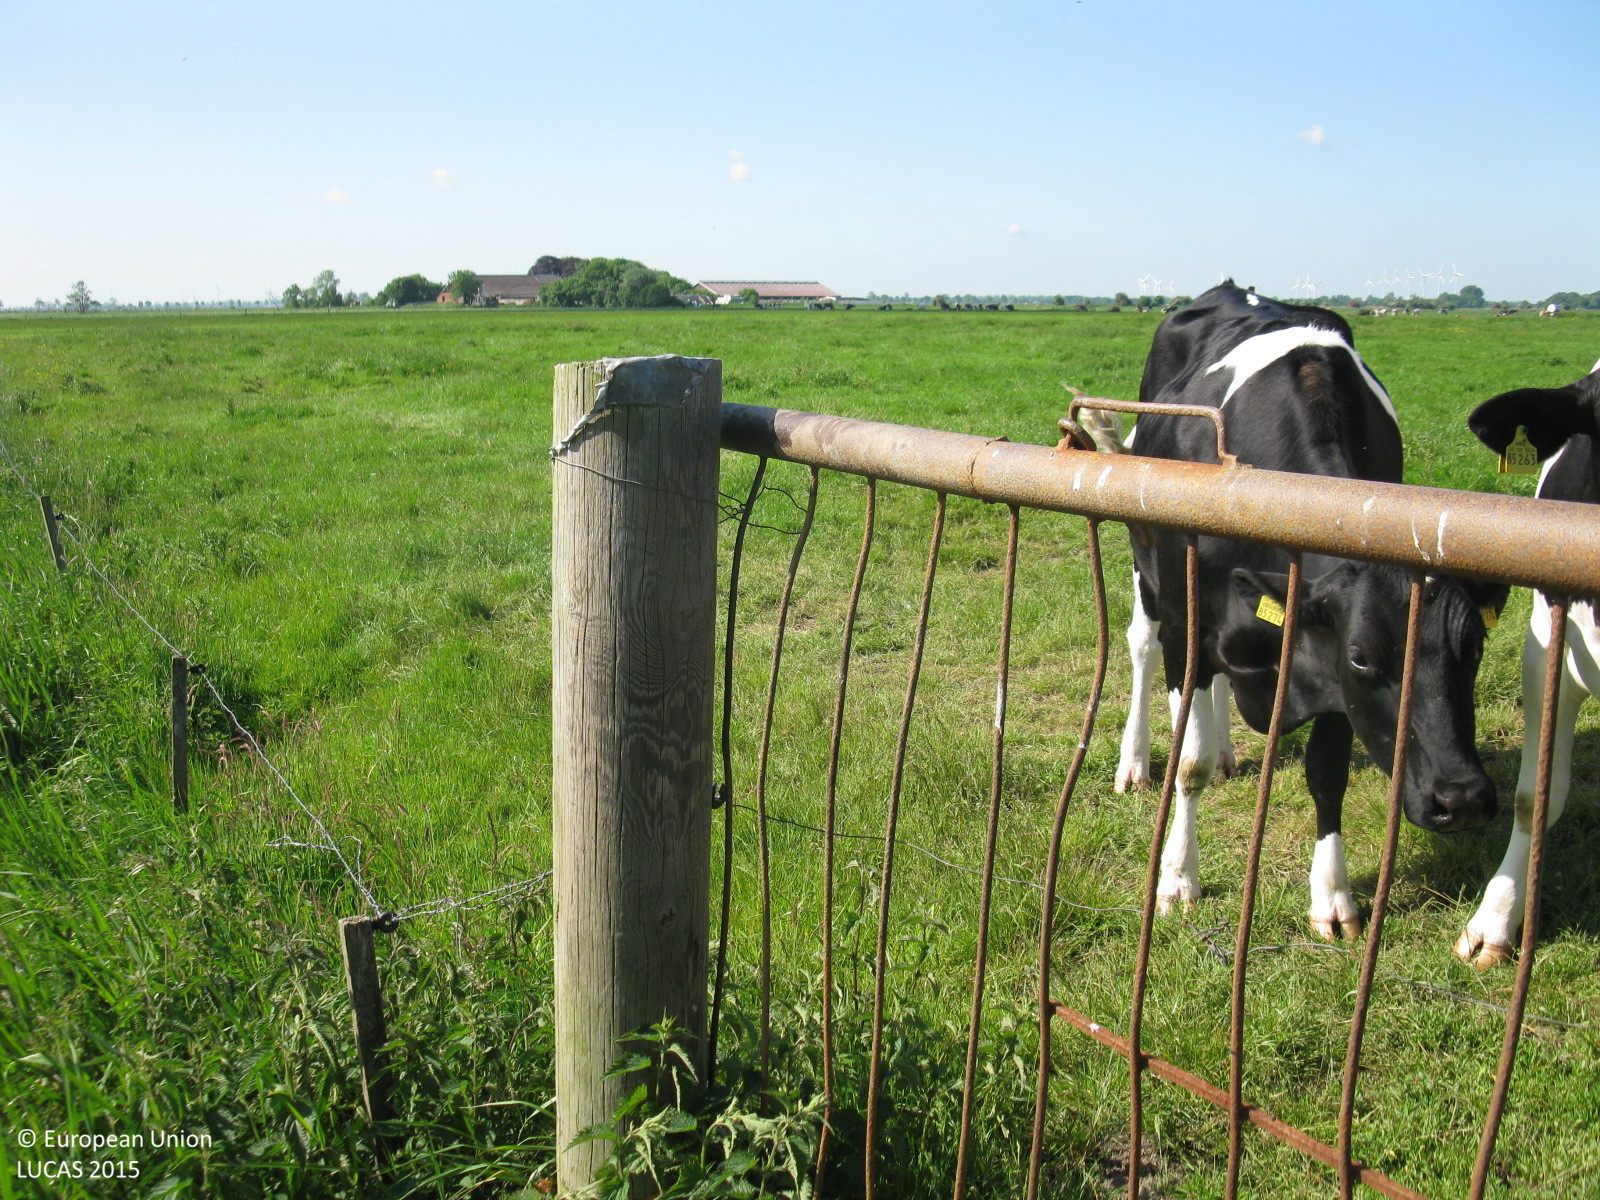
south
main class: Grassland
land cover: Grassland without tree/shrub cover
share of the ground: > 75 %
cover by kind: herbaceous plants 100 %
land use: Agriculture (excluding fallow land and kitchen gardens)
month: June
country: DE
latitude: 53.2471
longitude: 7.3480
